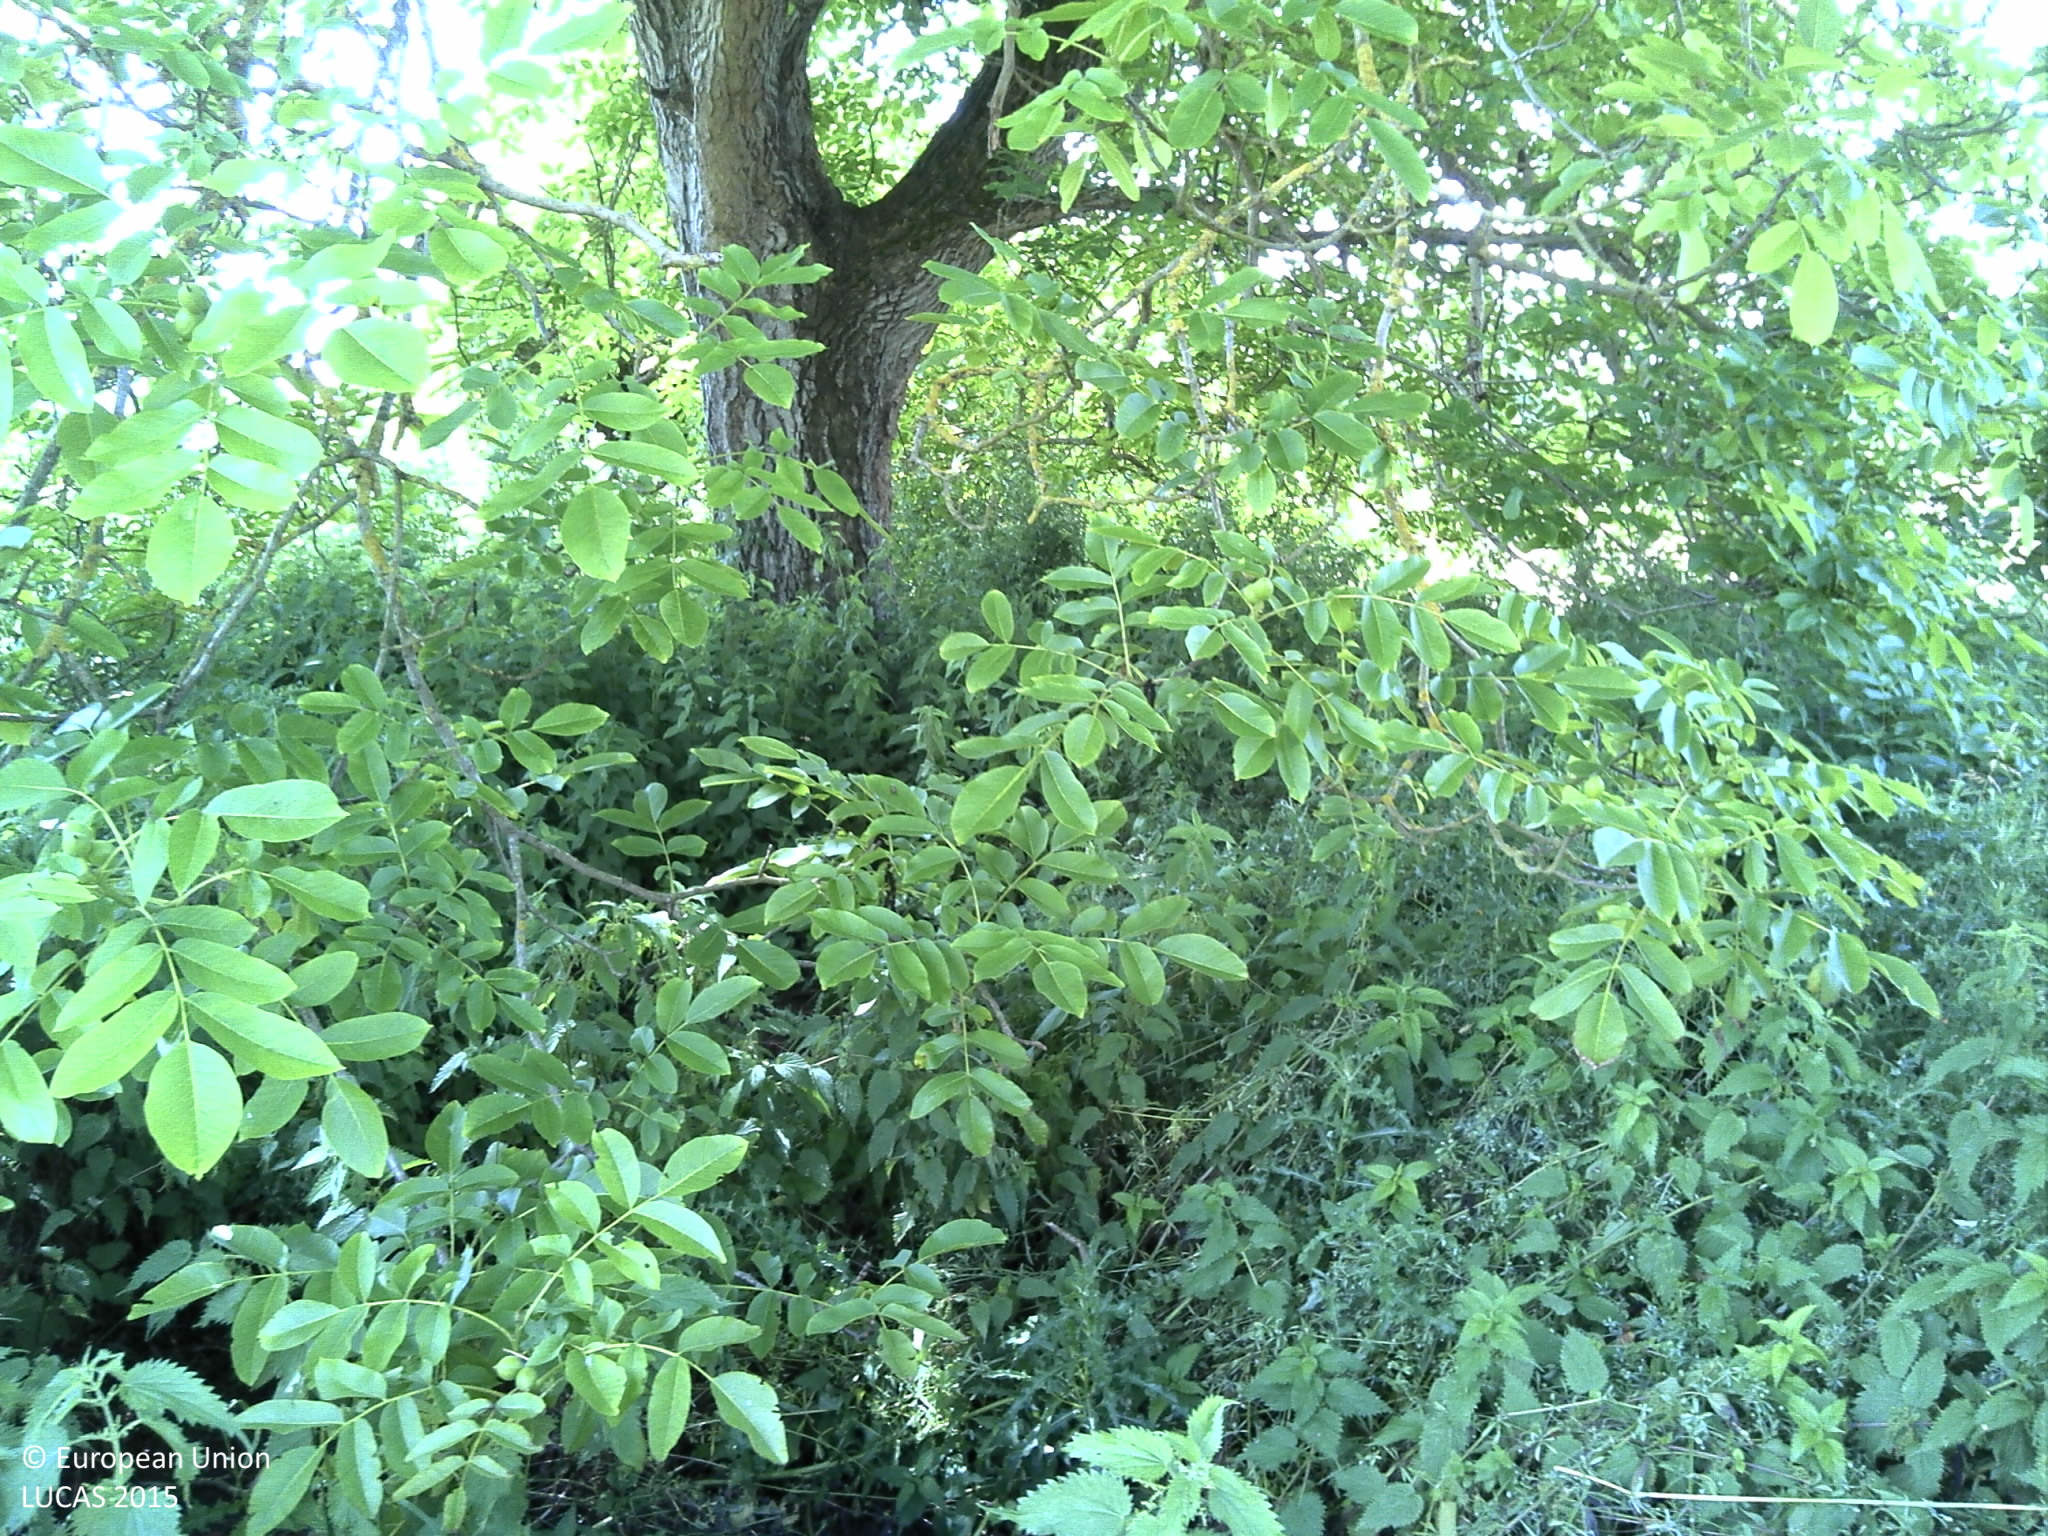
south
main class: Cropland
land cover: Nuts trees
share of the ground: 50 - 75 %
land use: Agriculture (excluding fallow land and kitchen gardens)
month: June
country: FR
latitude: 49.3227
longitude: 1.0215
